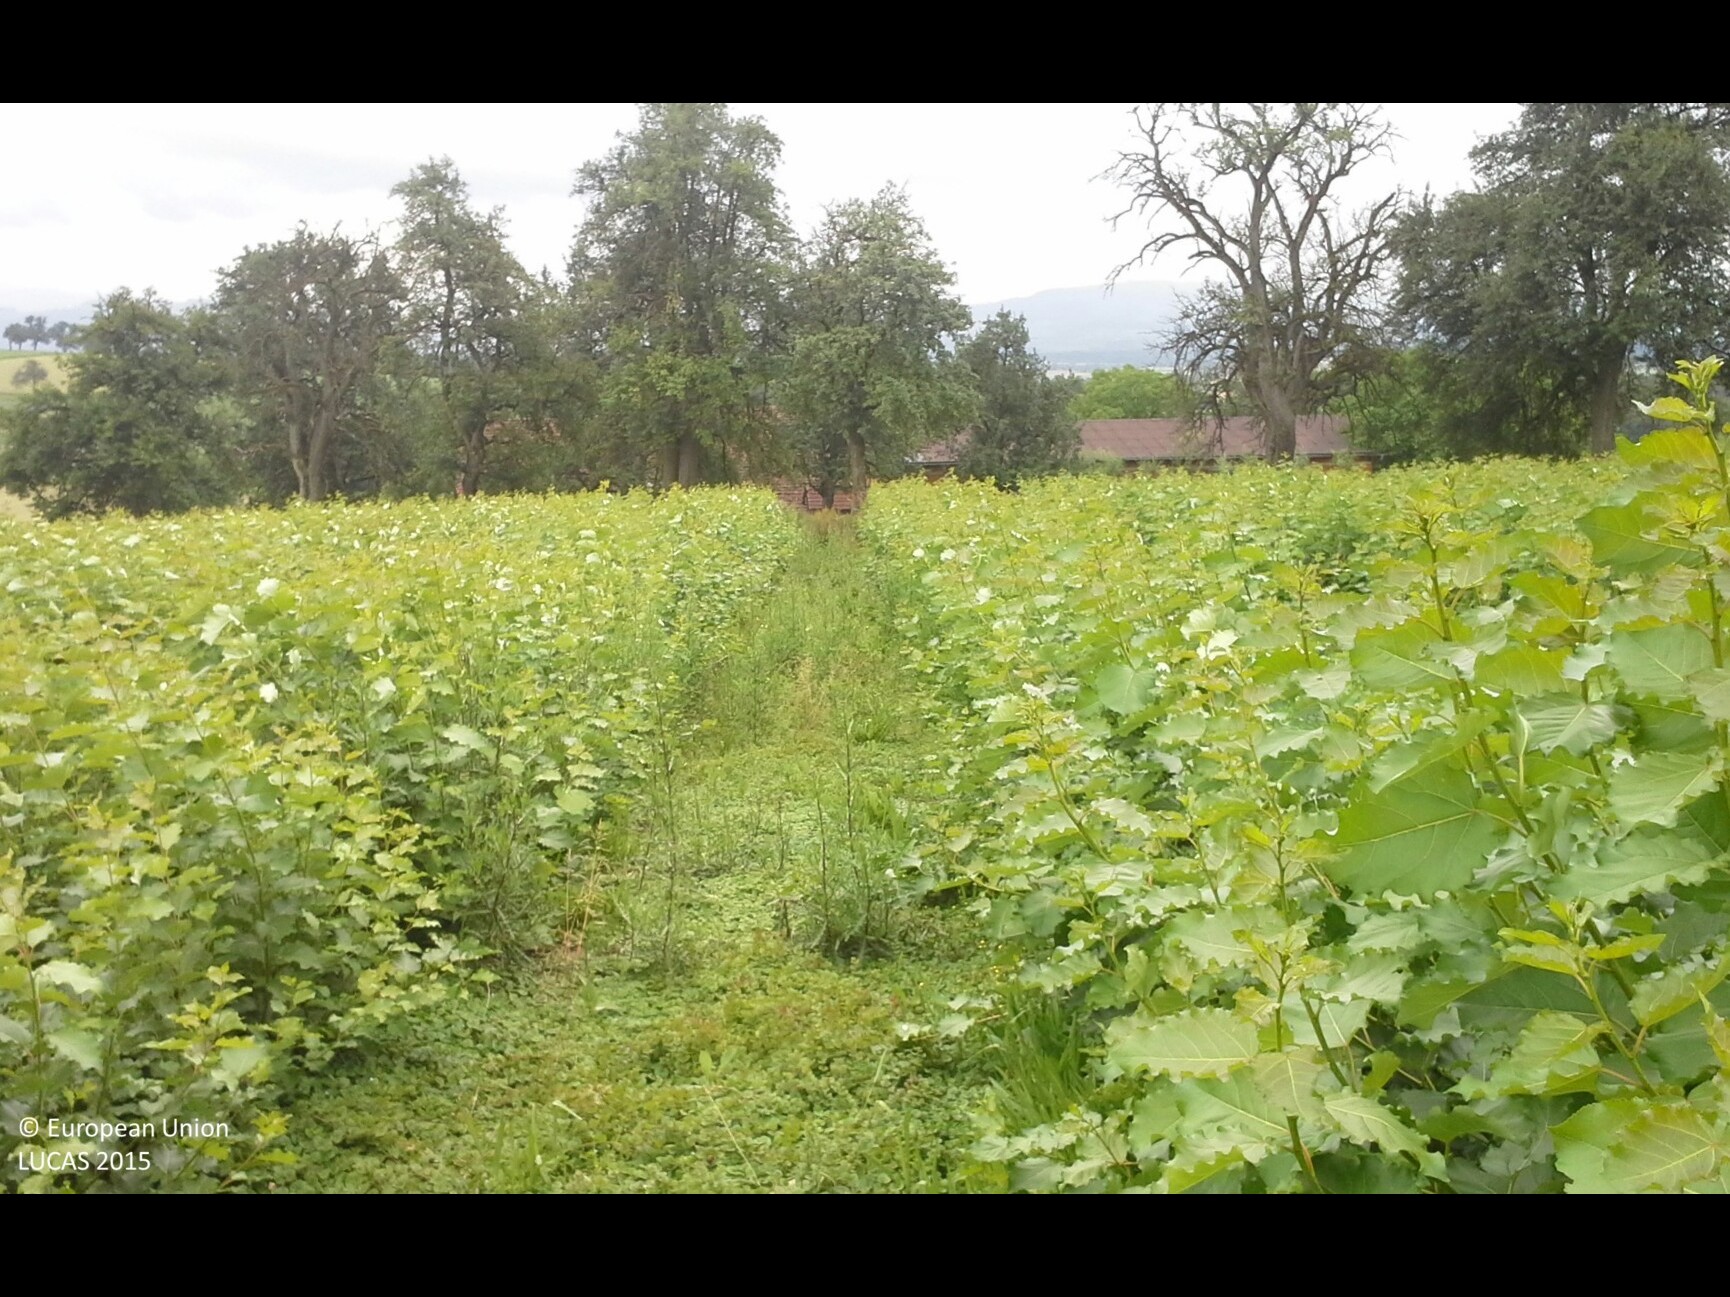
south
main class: Cropland
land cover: Other fruit trees and berries
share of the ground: 50 - 75 %
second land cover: Spontaneously vegetated surfaces
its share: 25 - 50 %
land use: Agriculture (excluding fallow land and kitchen gardens)
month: June
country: AT
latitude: 48.1093
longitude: 14.6071
